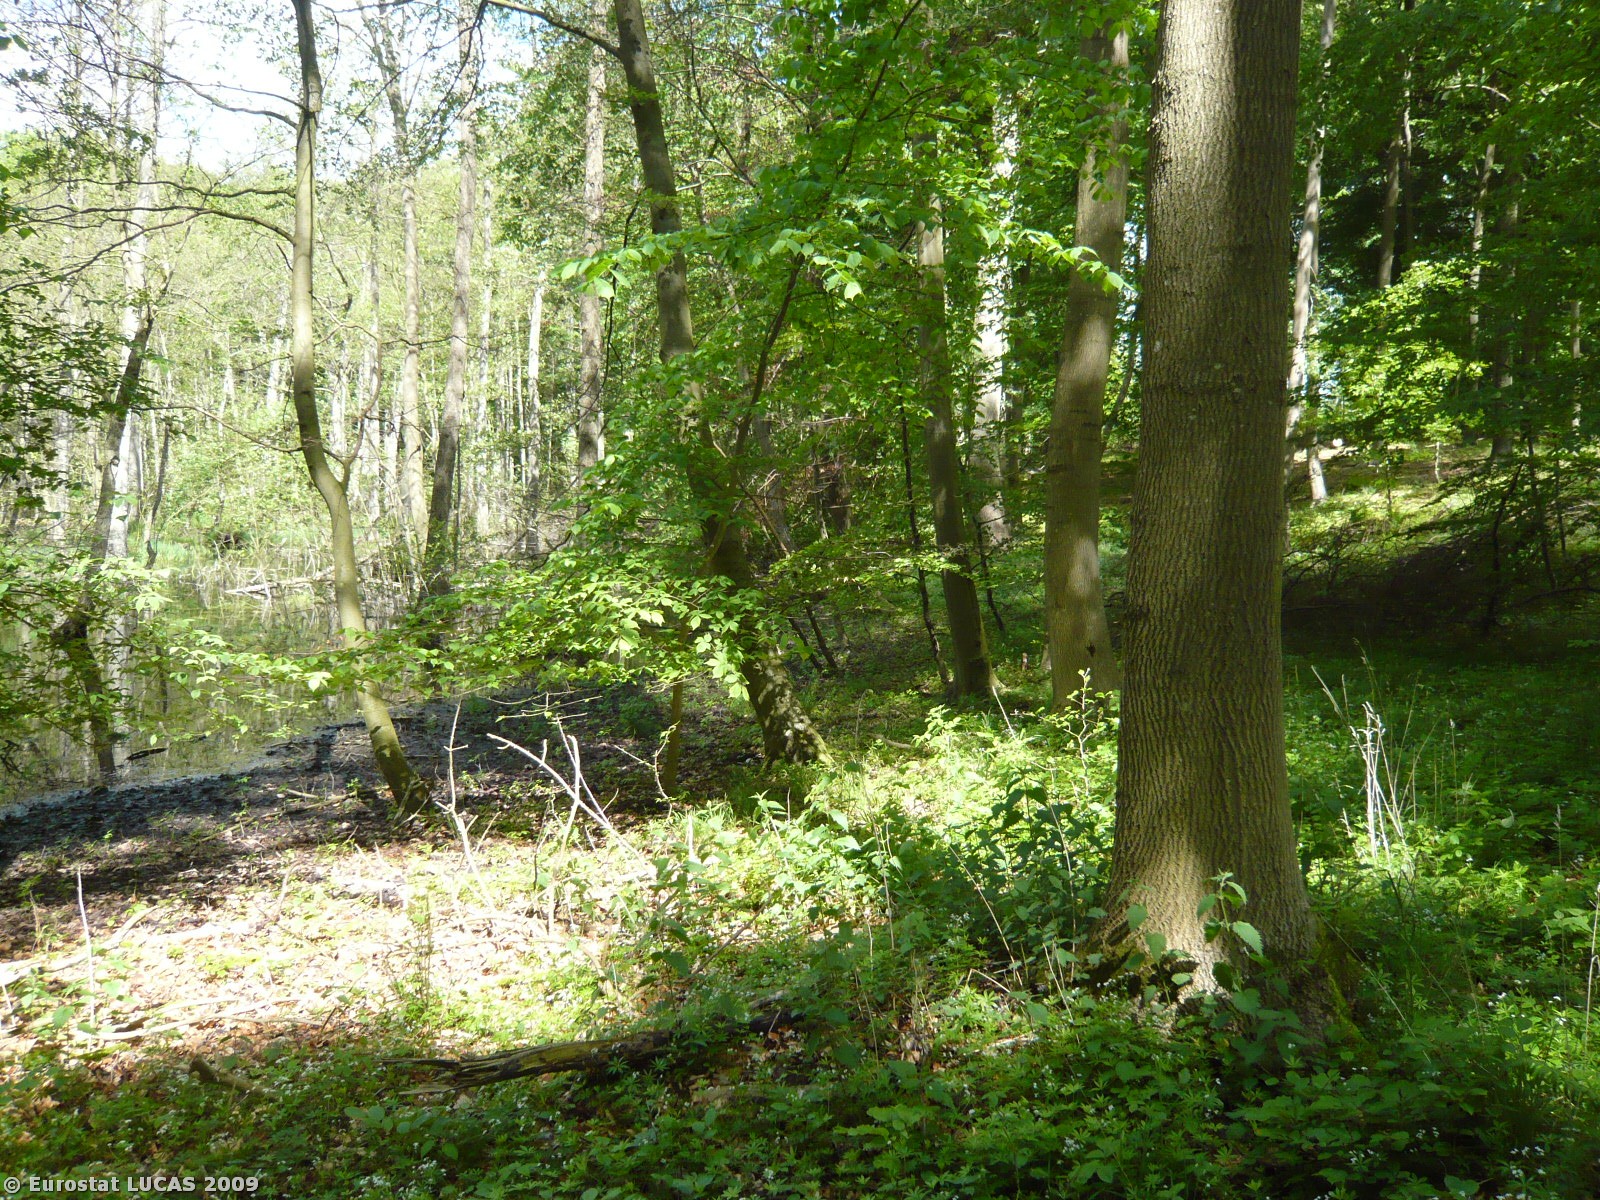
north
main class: Woodland
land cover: Broadleaved woodland
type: mesophytic deciduous forest
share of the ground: > 75 %
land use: Forestry
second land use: Amenities, museums, leisure
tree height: > 5 m
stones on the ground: < 10 %
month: May
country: DK
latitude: 55.6340
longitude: 11.9204
